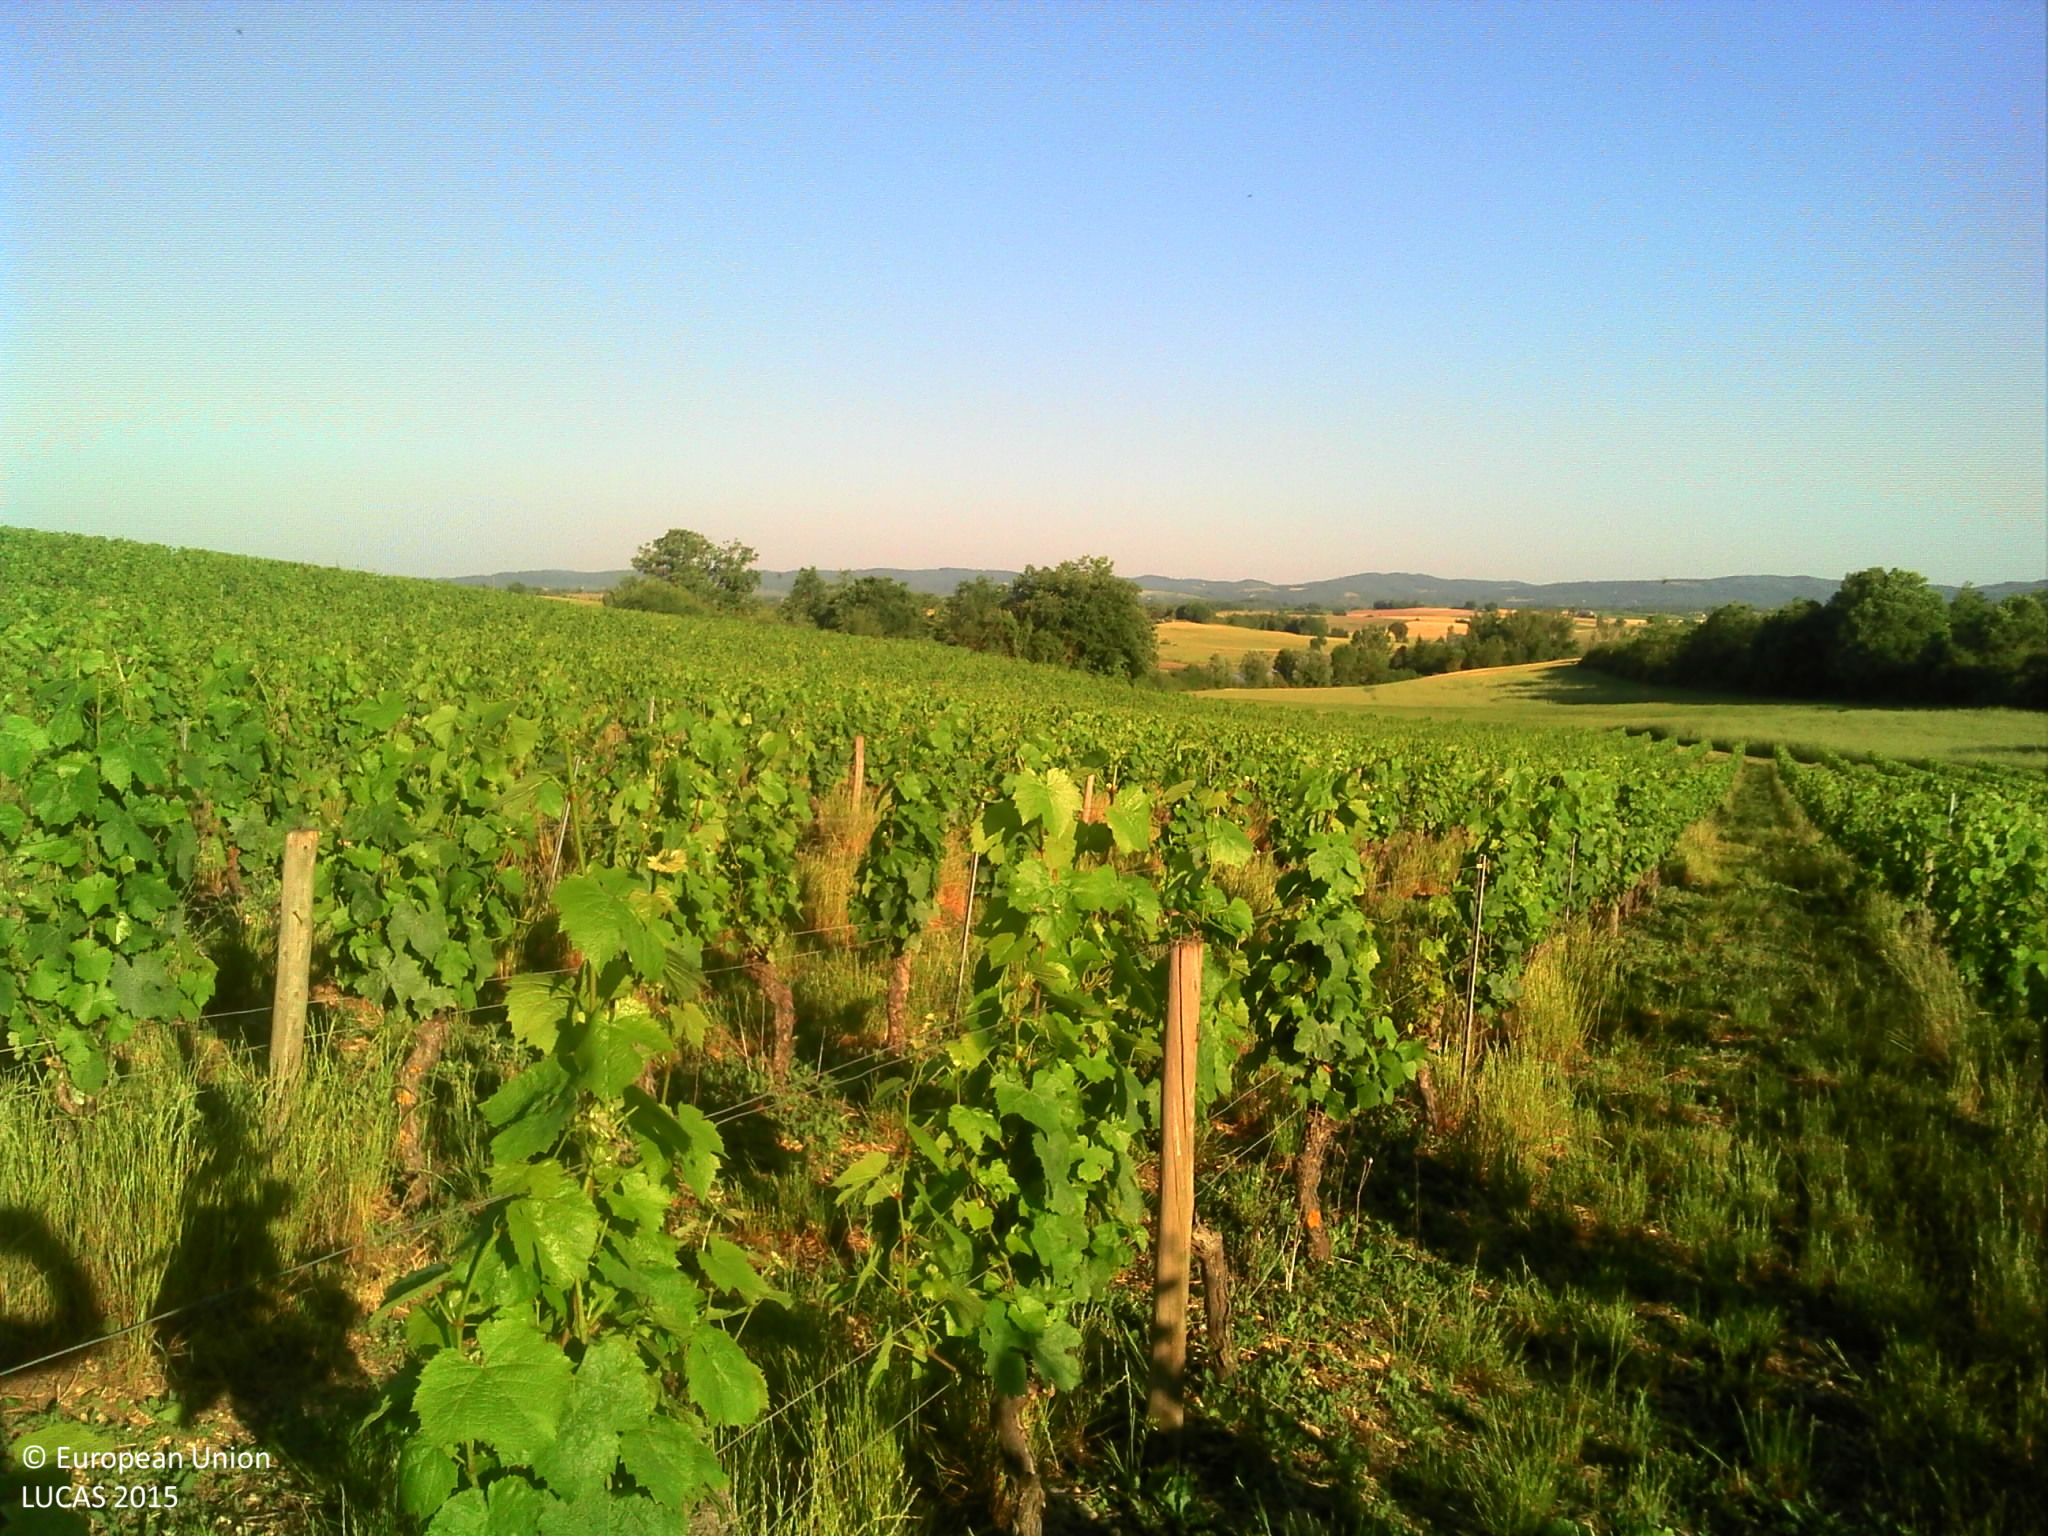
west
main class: Cropland
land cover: Vineyards
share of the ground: 10 - 25 %
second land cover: Spontaneously vegetated surfaces
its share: > 75 %
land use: Agriculture (excluding fallow land and kitchen gardens)
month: June
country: FR
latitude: 44.0179
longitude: 1.9315
